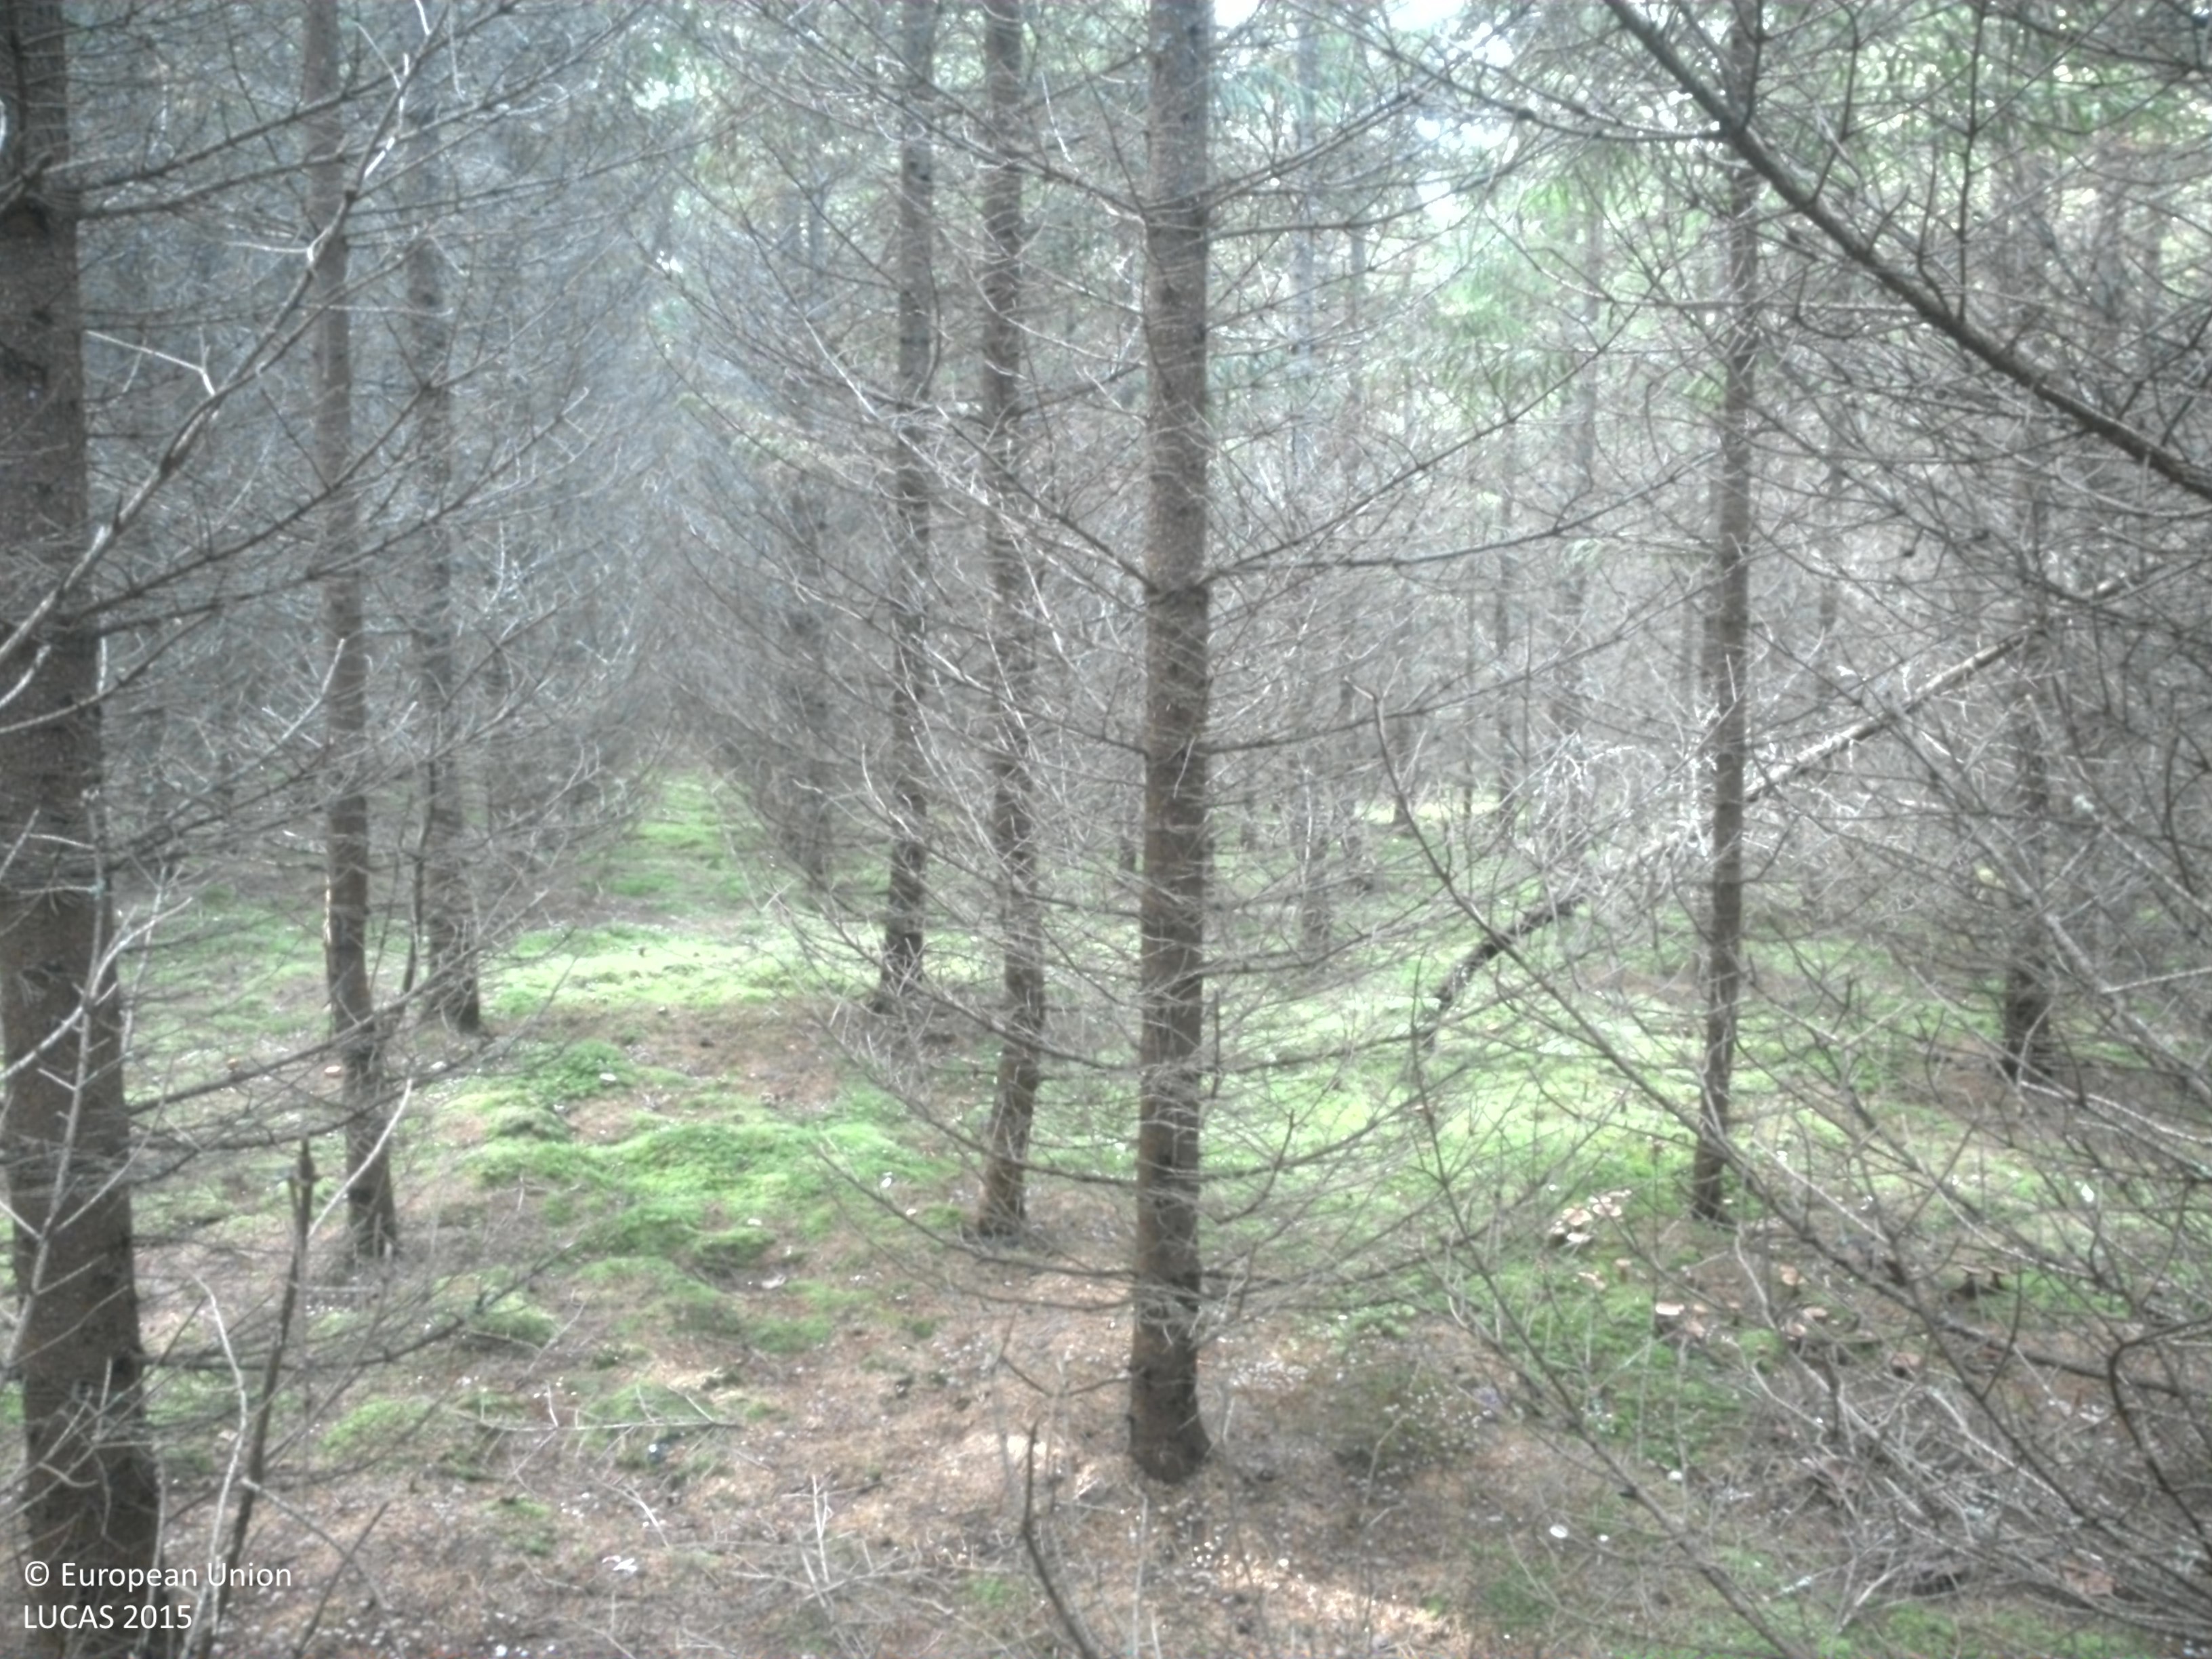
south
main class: Woodland
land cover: Spruce dominated coniferous woodland
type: boreal forest
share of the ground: > 75 %
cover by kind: coniferous forest trees 85 %, lichens and mosses 15 %
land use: Forestry
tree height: > 5 m
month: September
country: SE
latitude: 59.4800
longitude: 15.4462
